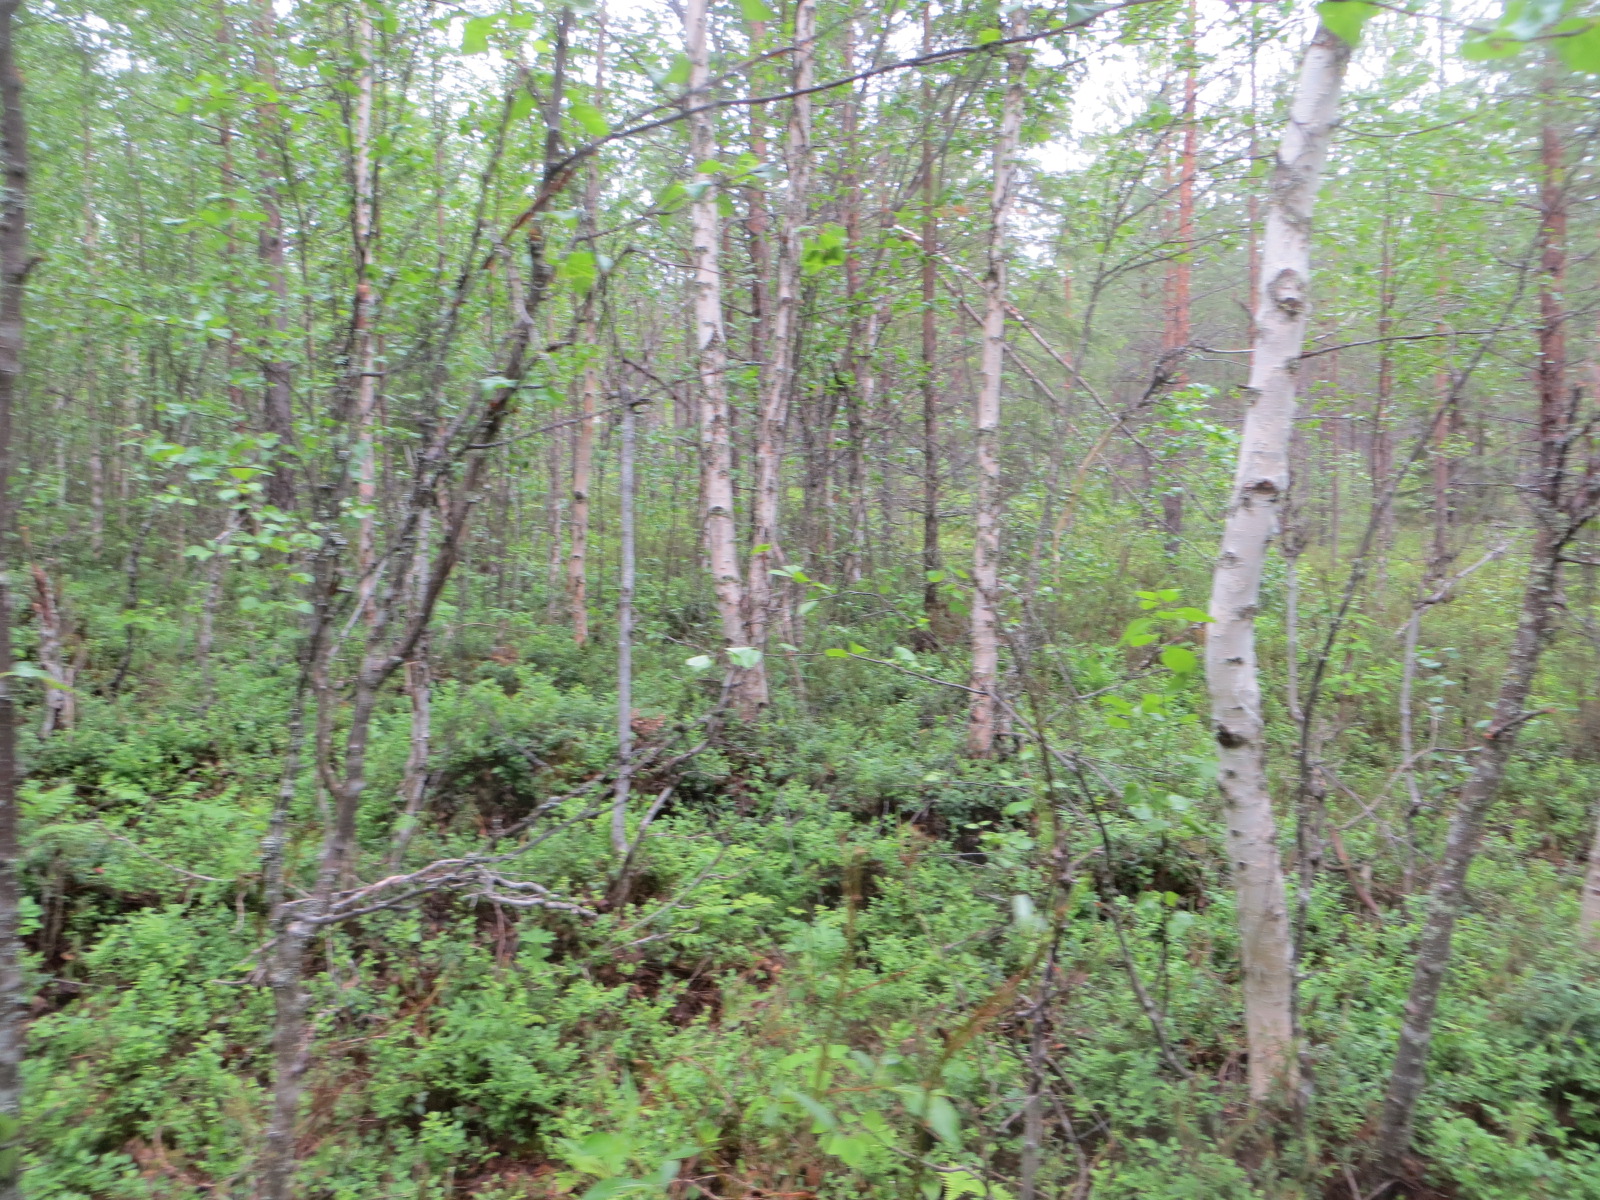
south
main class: Woodland
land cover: Pine dominated mixed woodland
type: boreal forest
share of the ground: > 75 %
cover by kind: broadleaved forest trees 45 %, coniferous forest trees 35 %, shrubs 20 %
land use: Forestry
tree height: > 5 m
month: June
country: FI
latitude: 66.4297
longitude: 26.4237
